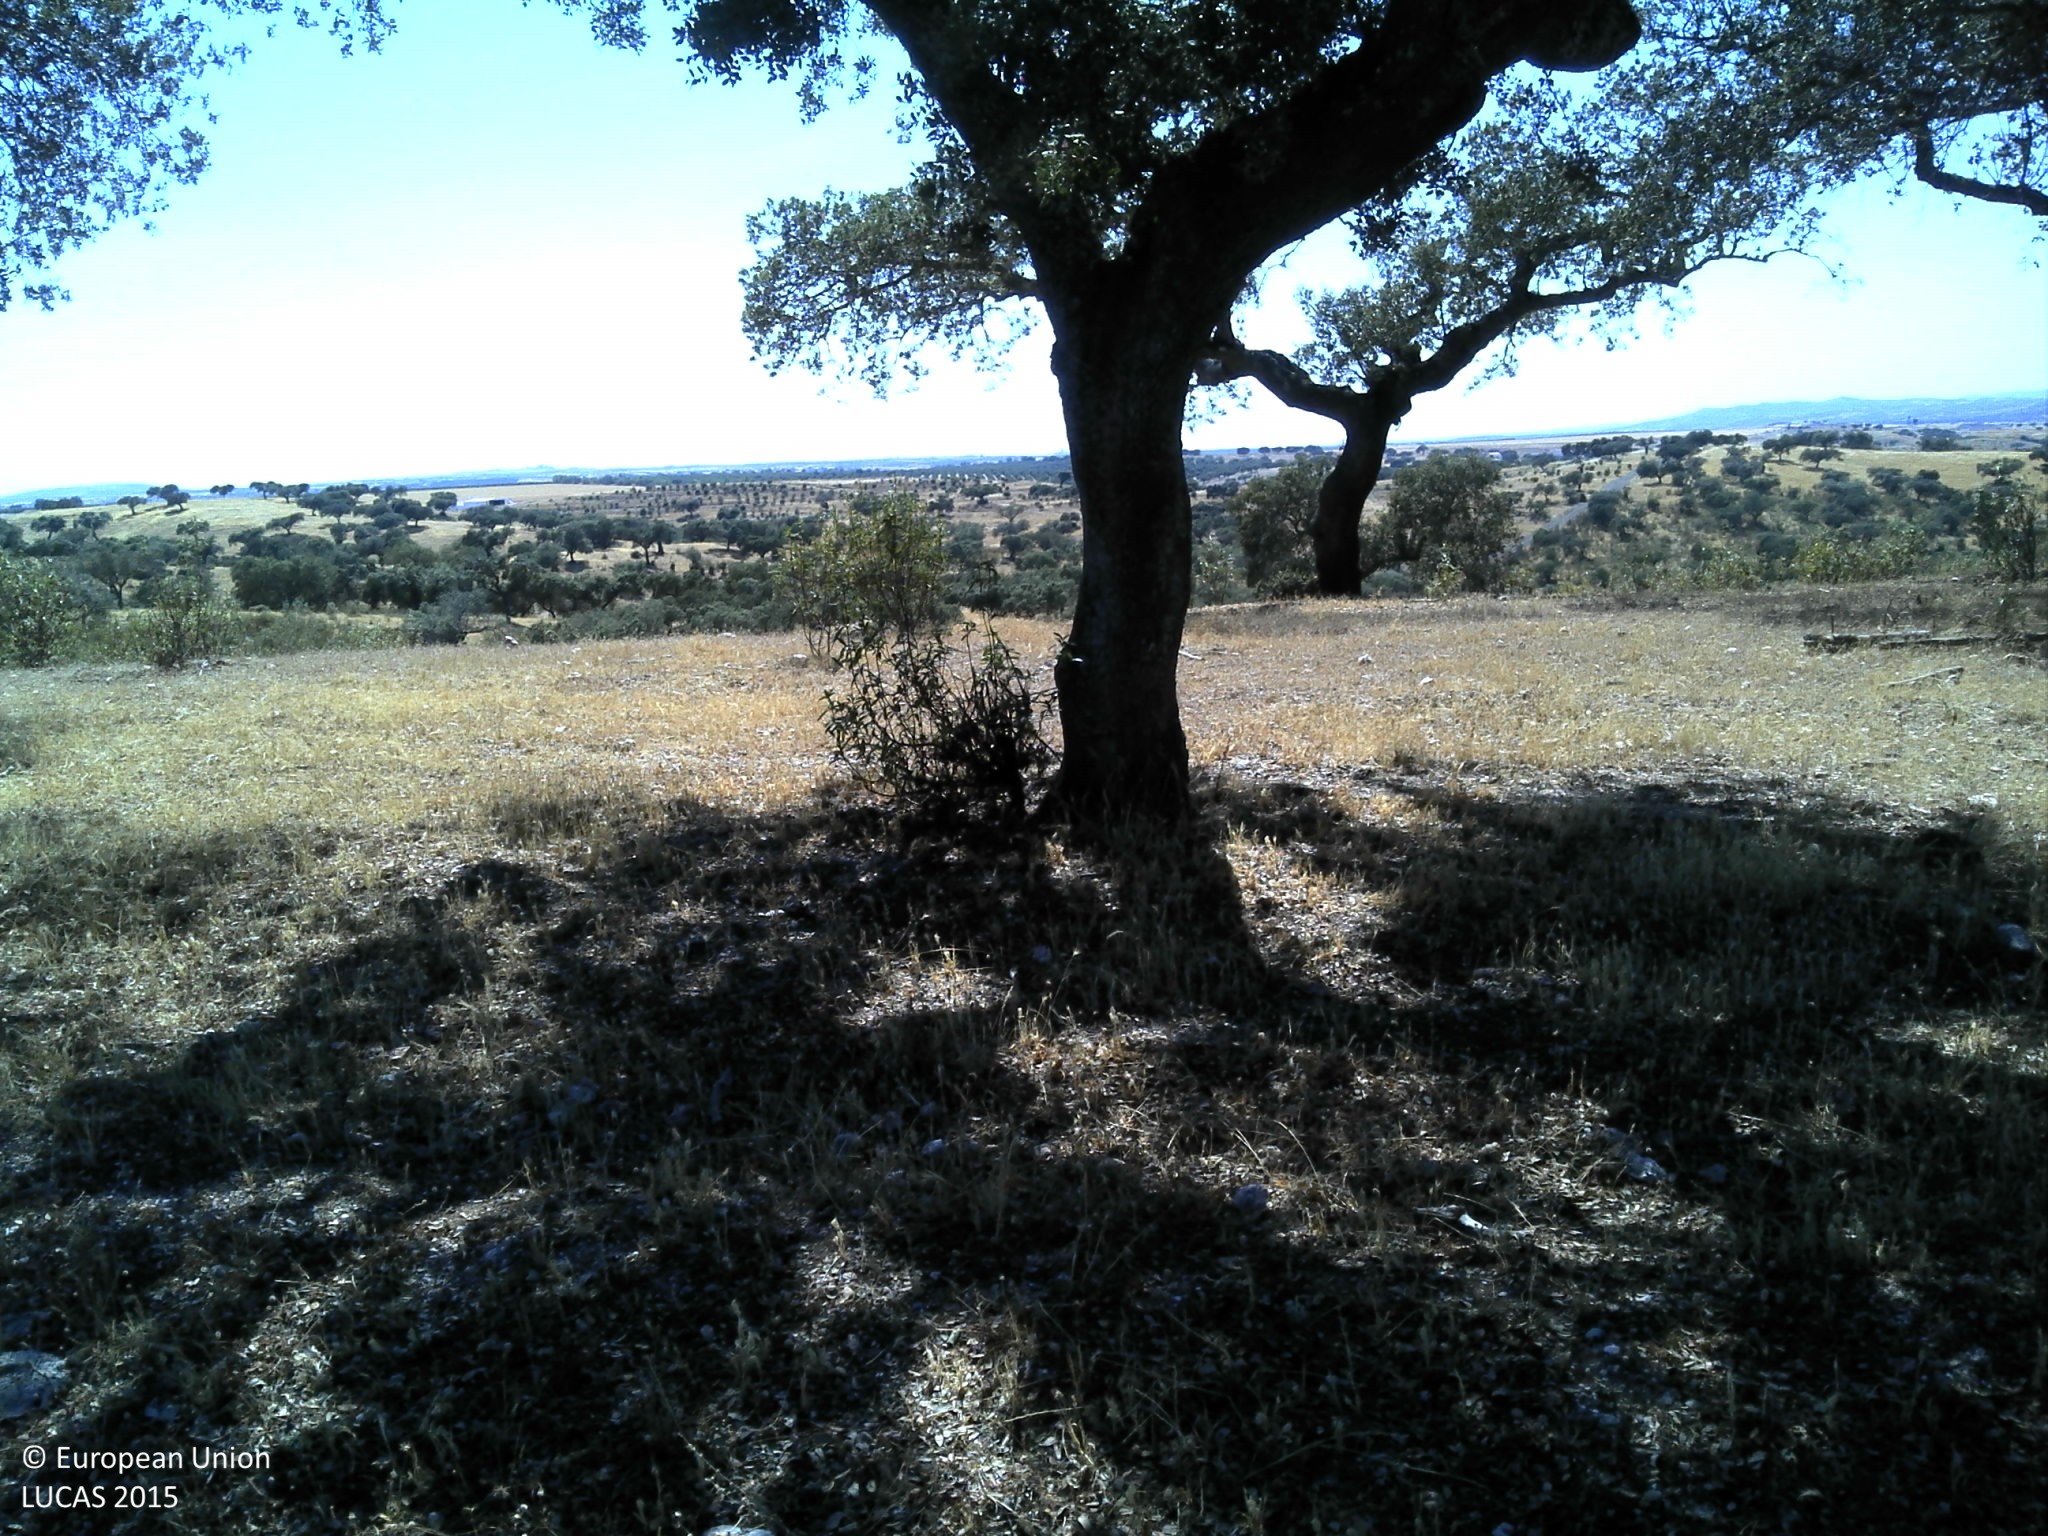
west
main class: Woodland
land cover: Broadleaved woodland
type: broadleaved evergreen forest
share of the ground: 25 - 50 %
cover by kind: broadleaved forest trees 45 %, unconsolidated bare surface 35 %, herbaceous plants 20 %
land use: Forestry
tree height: > 5 m
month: July
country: PT
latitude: 38.1576
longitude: -7.3311
